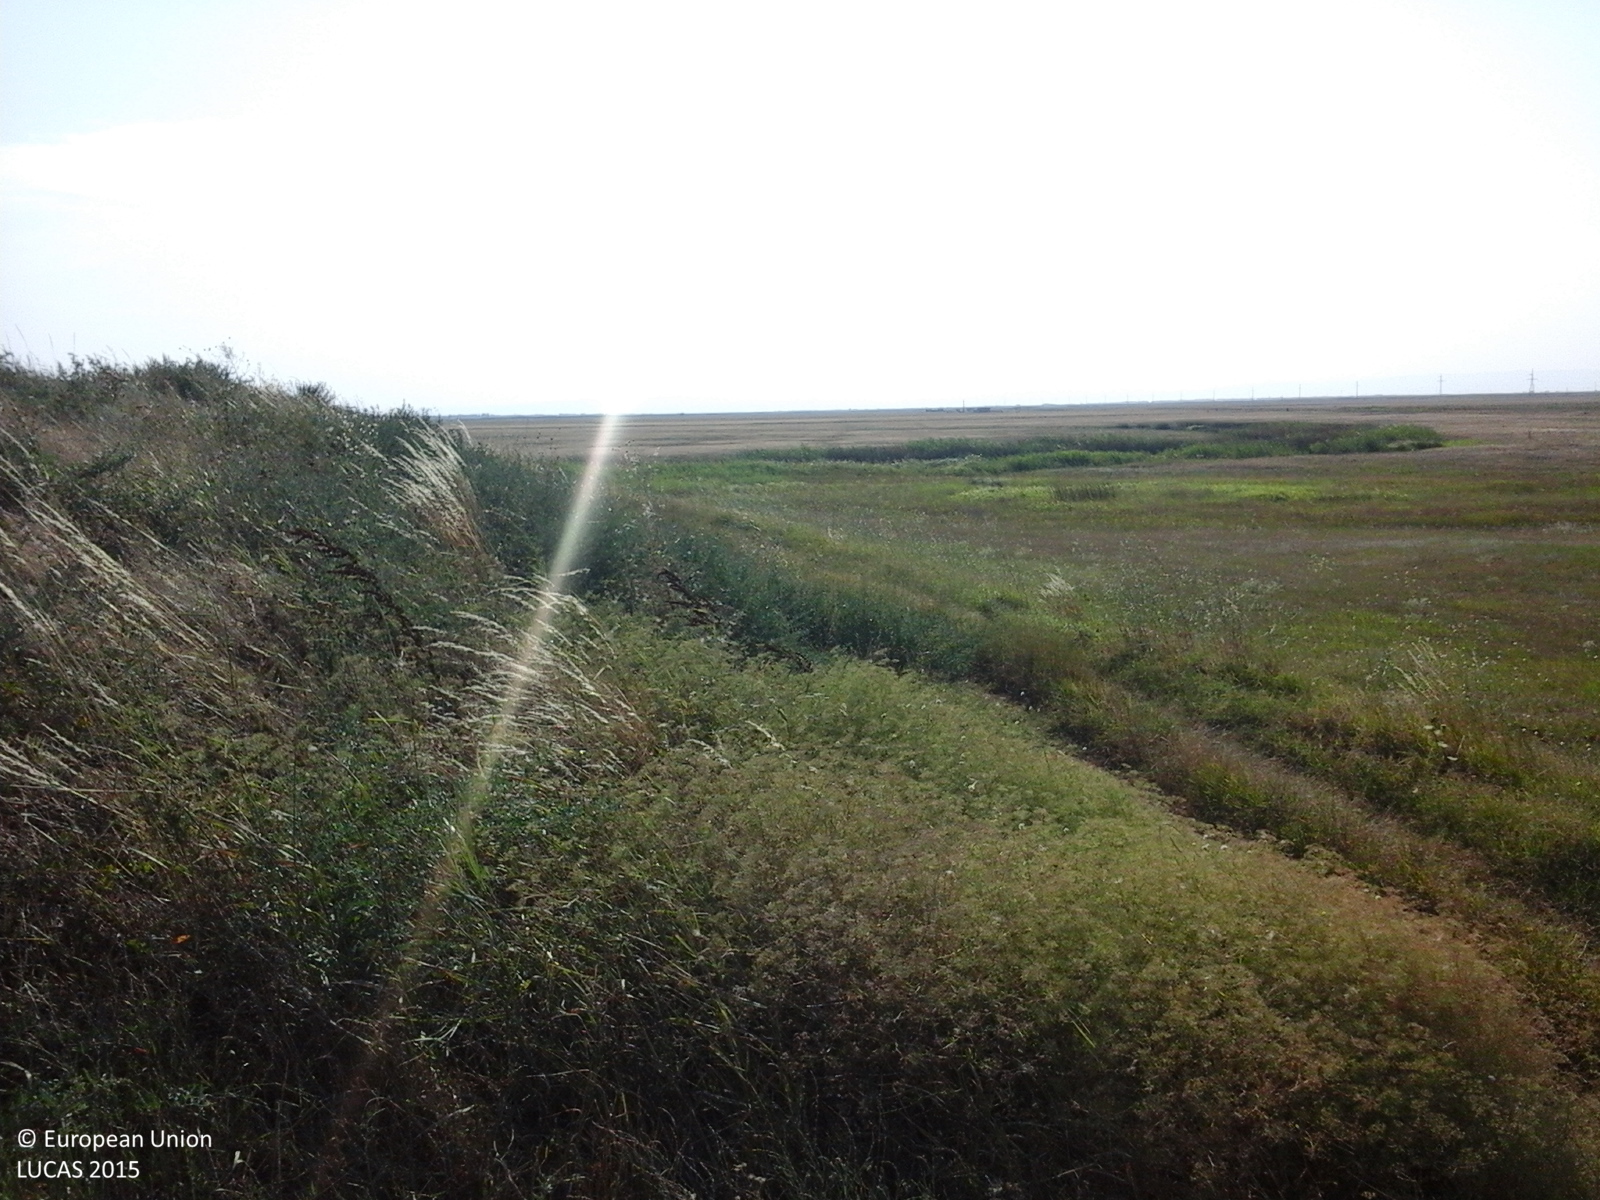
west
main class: Grassland
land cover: Grassland without tree/shrub cover
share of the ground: > 75 %
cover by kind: herbaceous plants 100 %
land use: Agriculture (excluding fallow land and kitchen gardens)
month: August
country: RO
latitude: 45.5765
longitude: 27.4928
